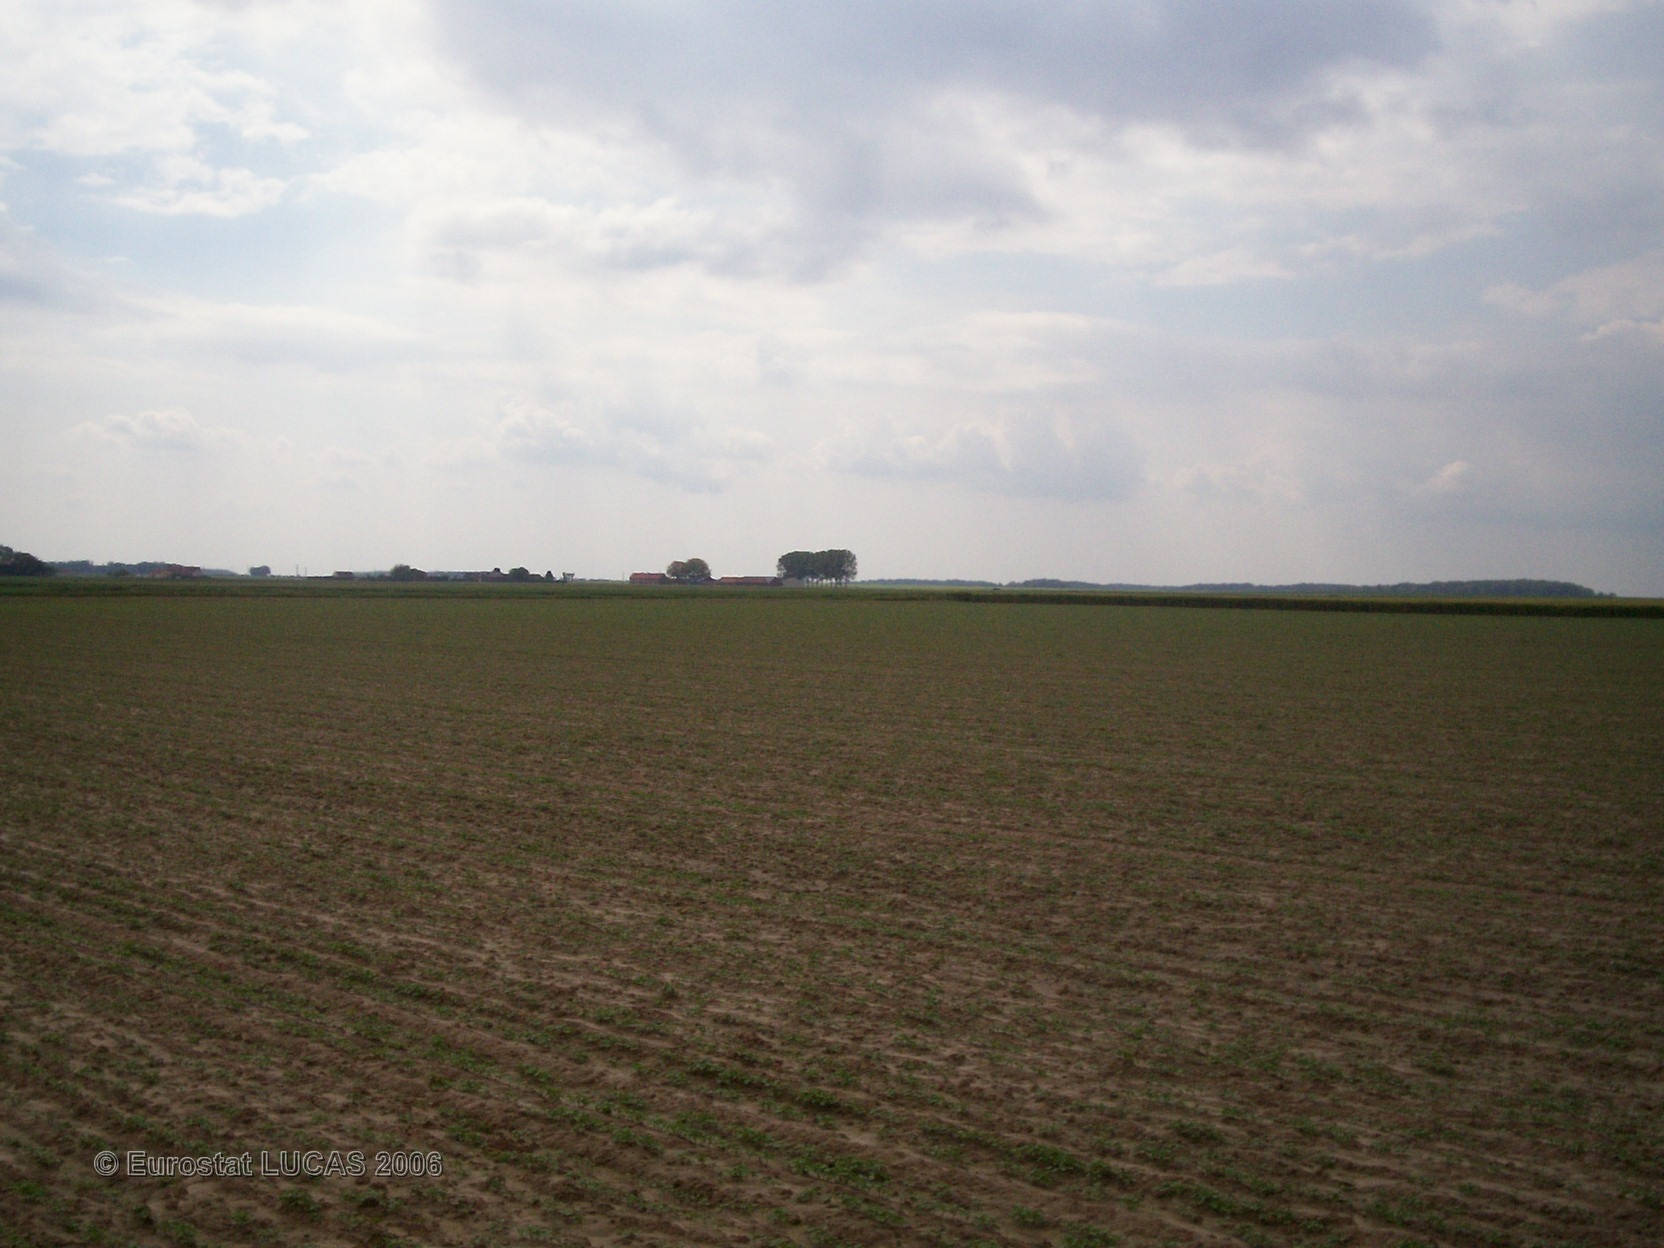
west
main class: Cropland
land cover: Other root crops
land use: Agriculture (excluding fallow land and kitchen gardens)
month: June
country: FR
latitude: 49.7319
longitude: 2.6772
